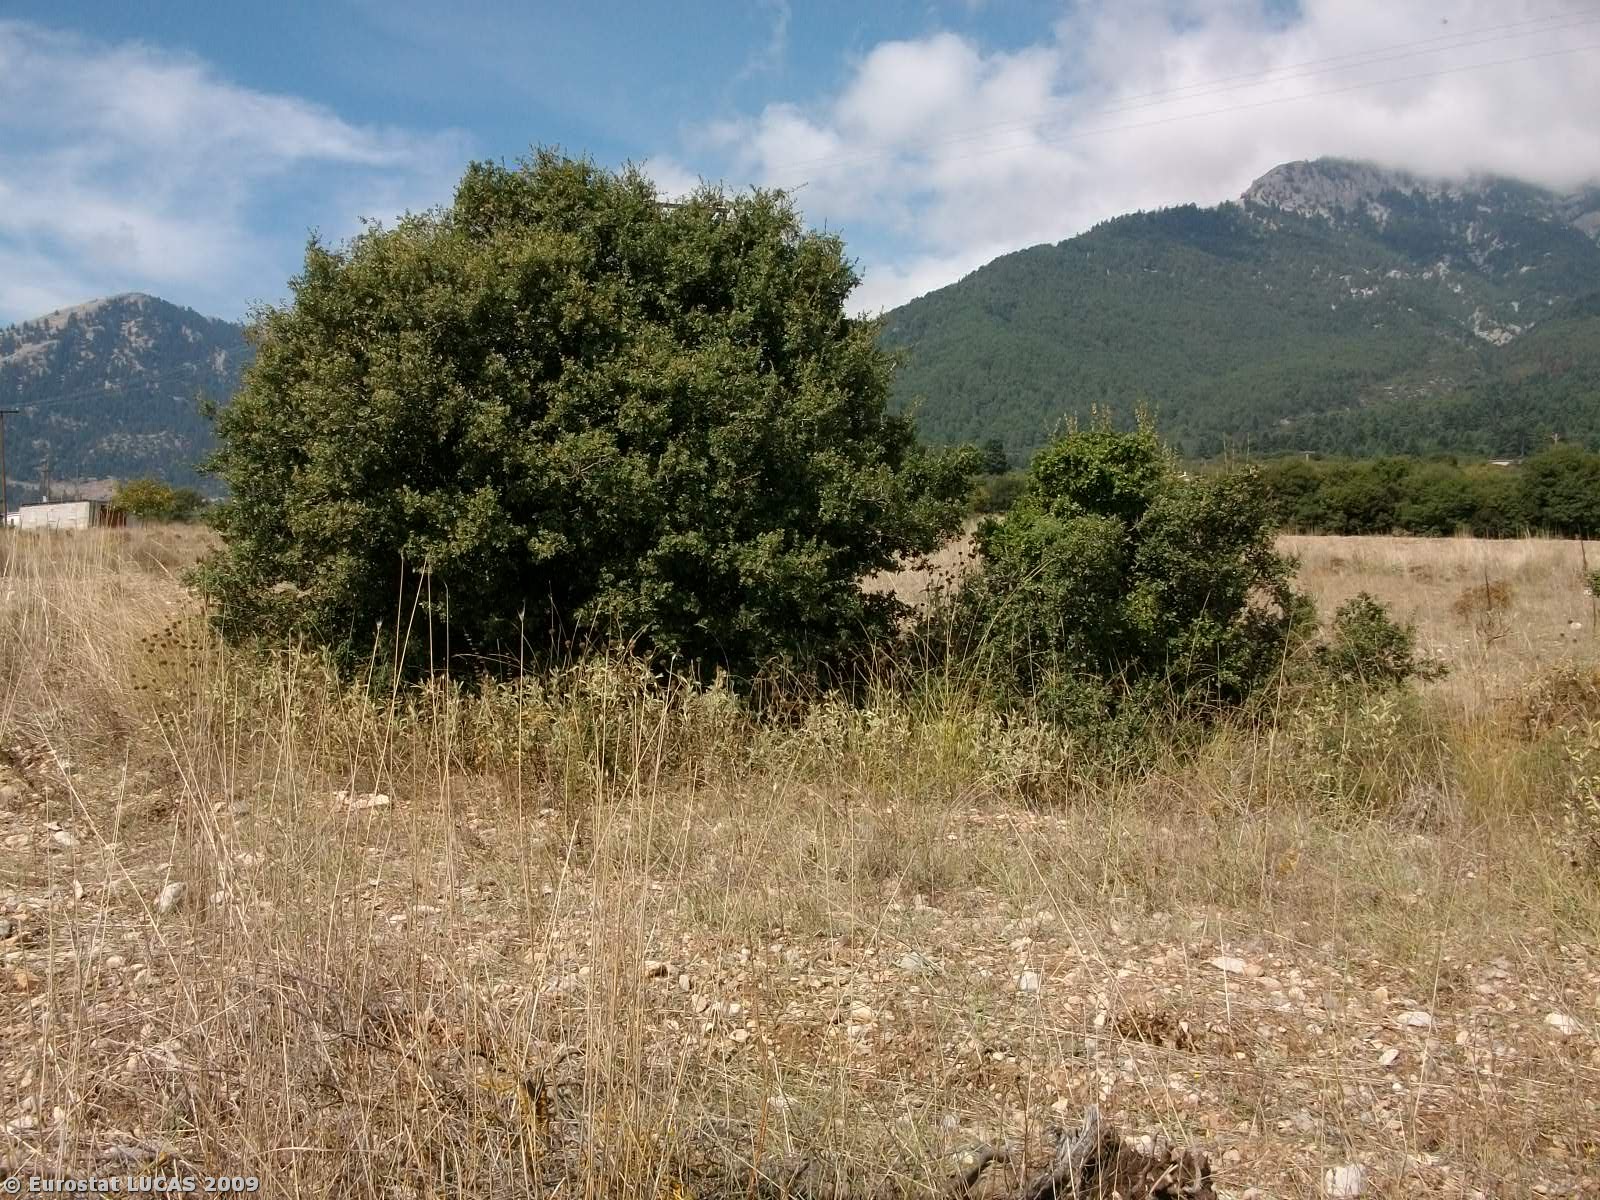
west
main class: Grassland
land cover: Grassland without tree/shrub cover
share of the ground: > 75 %
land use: Agriculture (excluding fallow land and kitchen gardens)
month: September
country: GR
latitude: 37.8827
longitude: 22.2798
